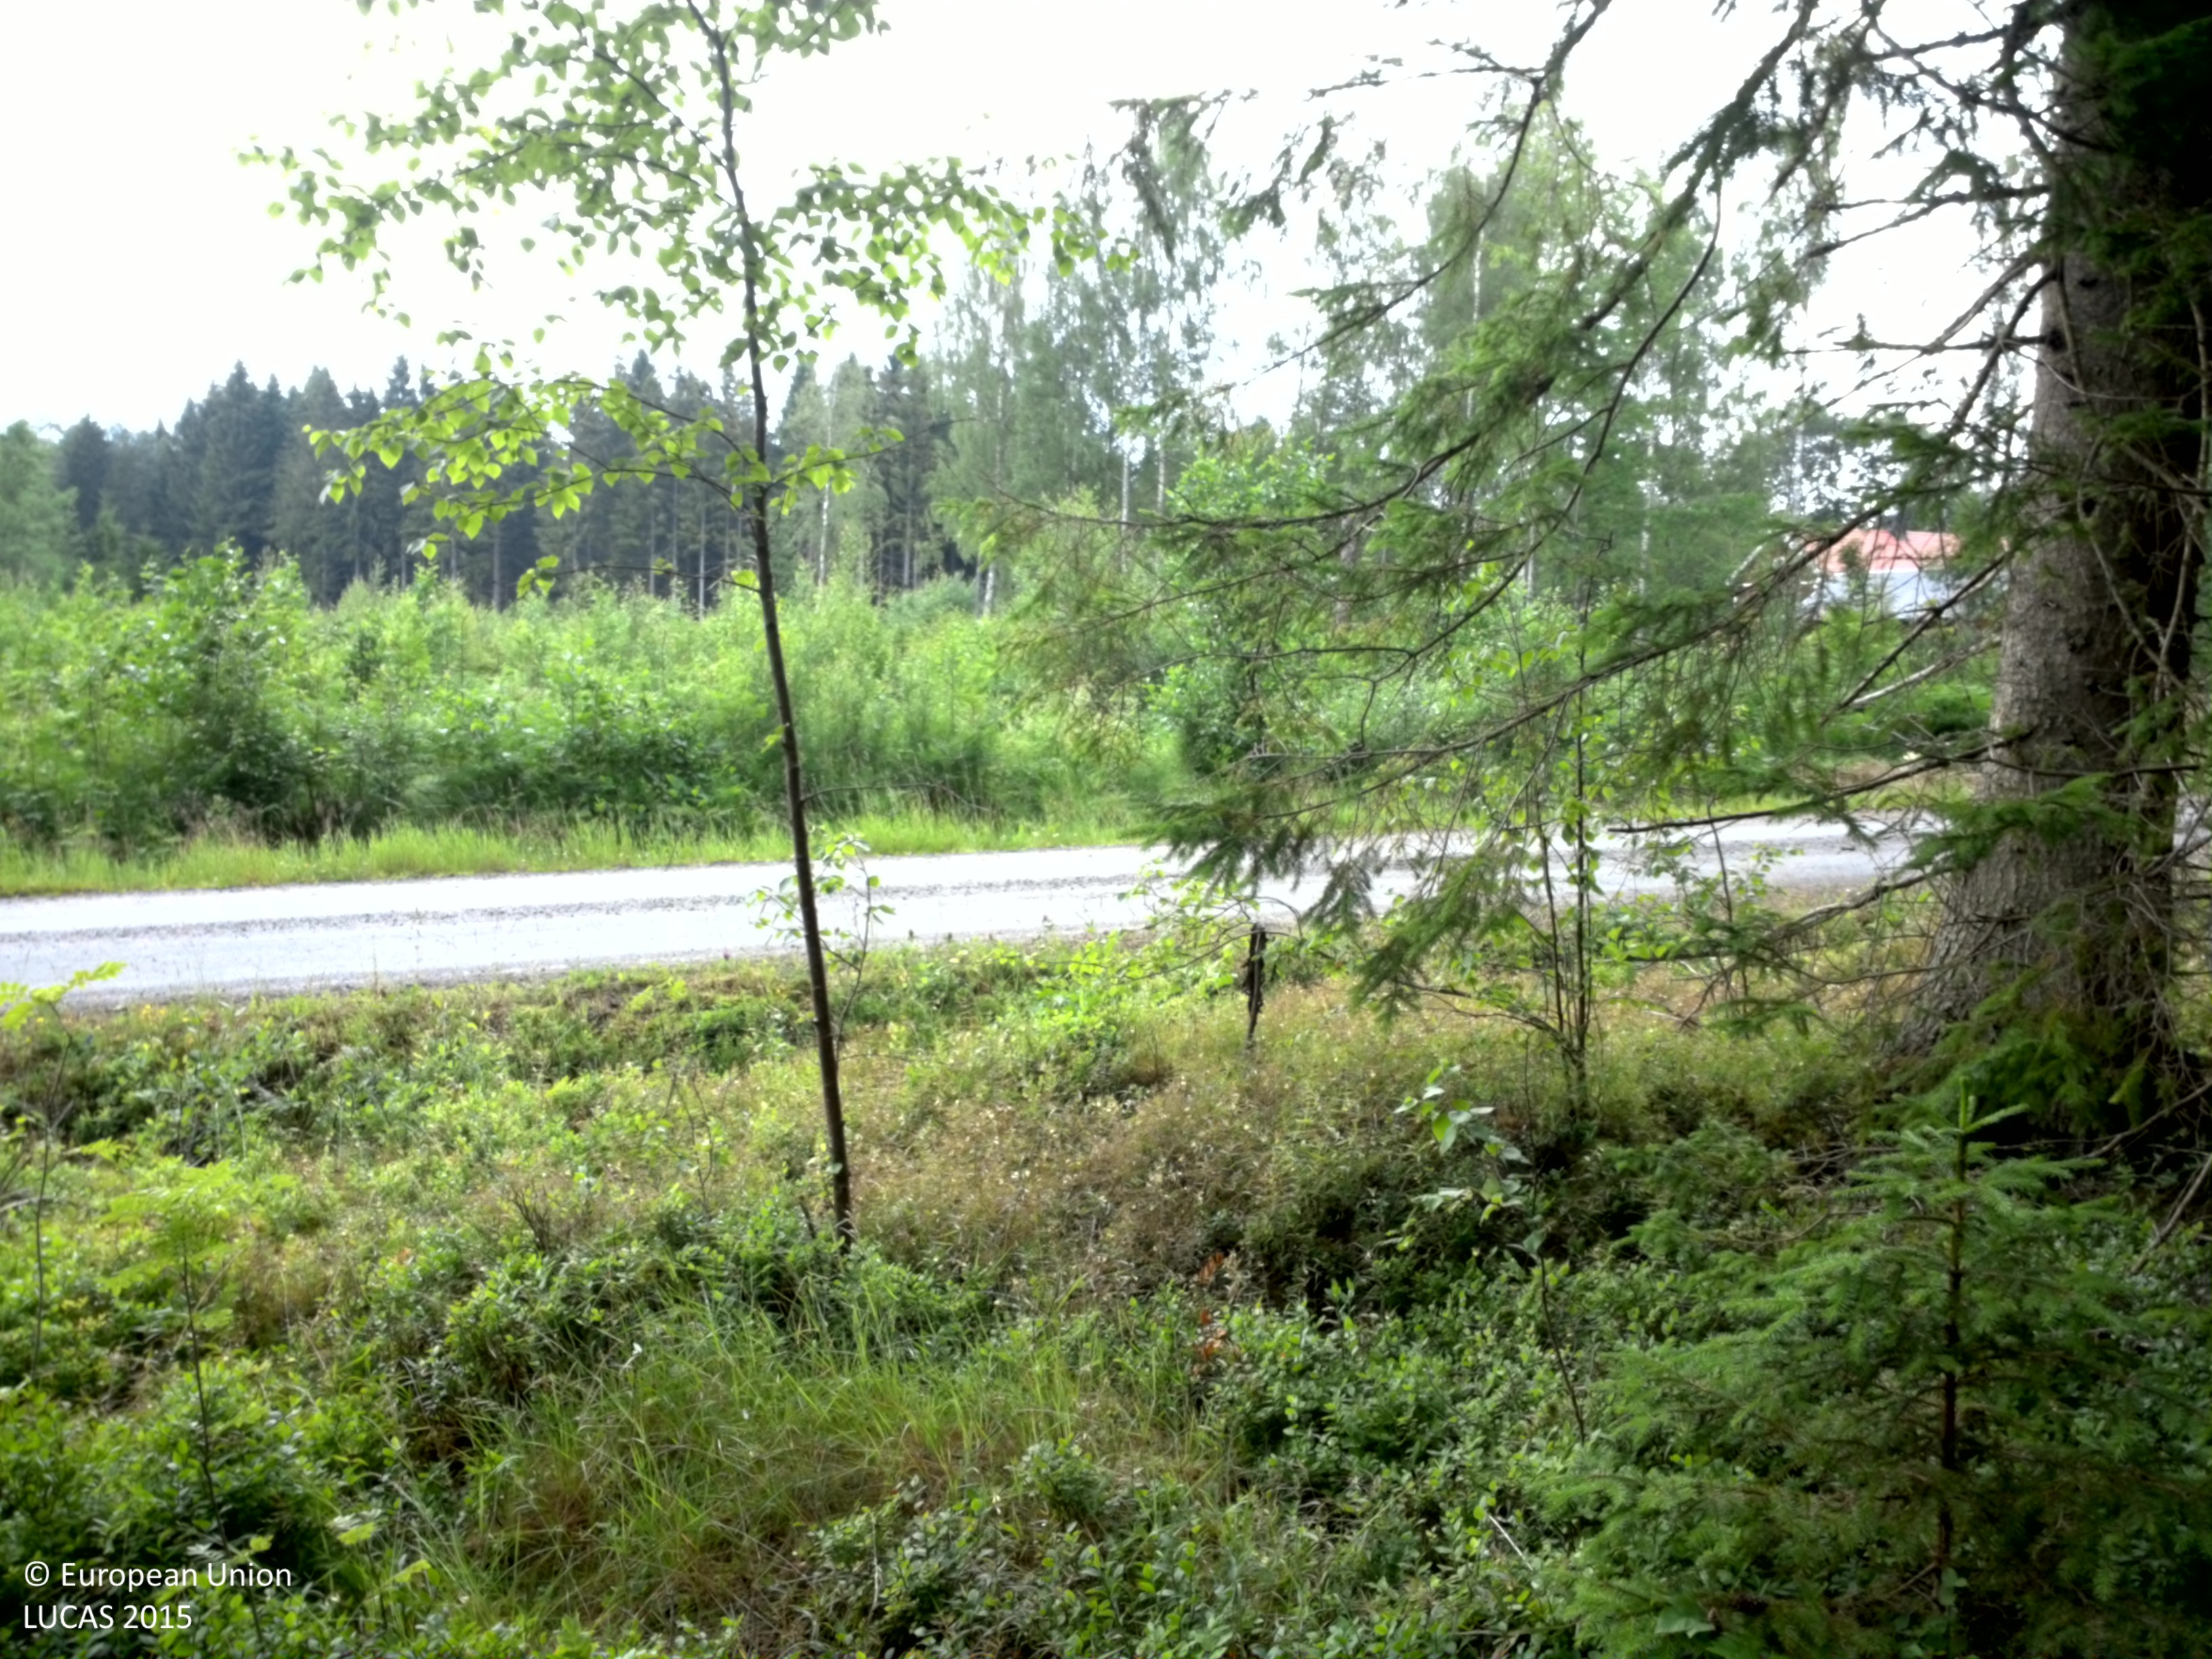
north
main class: Woodland
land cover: Other mixed woodland
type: boreal forest
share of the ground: 50 - 75 %
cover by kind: coniferous forest trees 40 %, shrubs 30 %, broadleaved forest trees 25 %, lichens and mosses 5 %
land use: Forestry
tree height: > 5 m
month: July
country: SE
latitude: 58.7411
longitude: 14.4333
